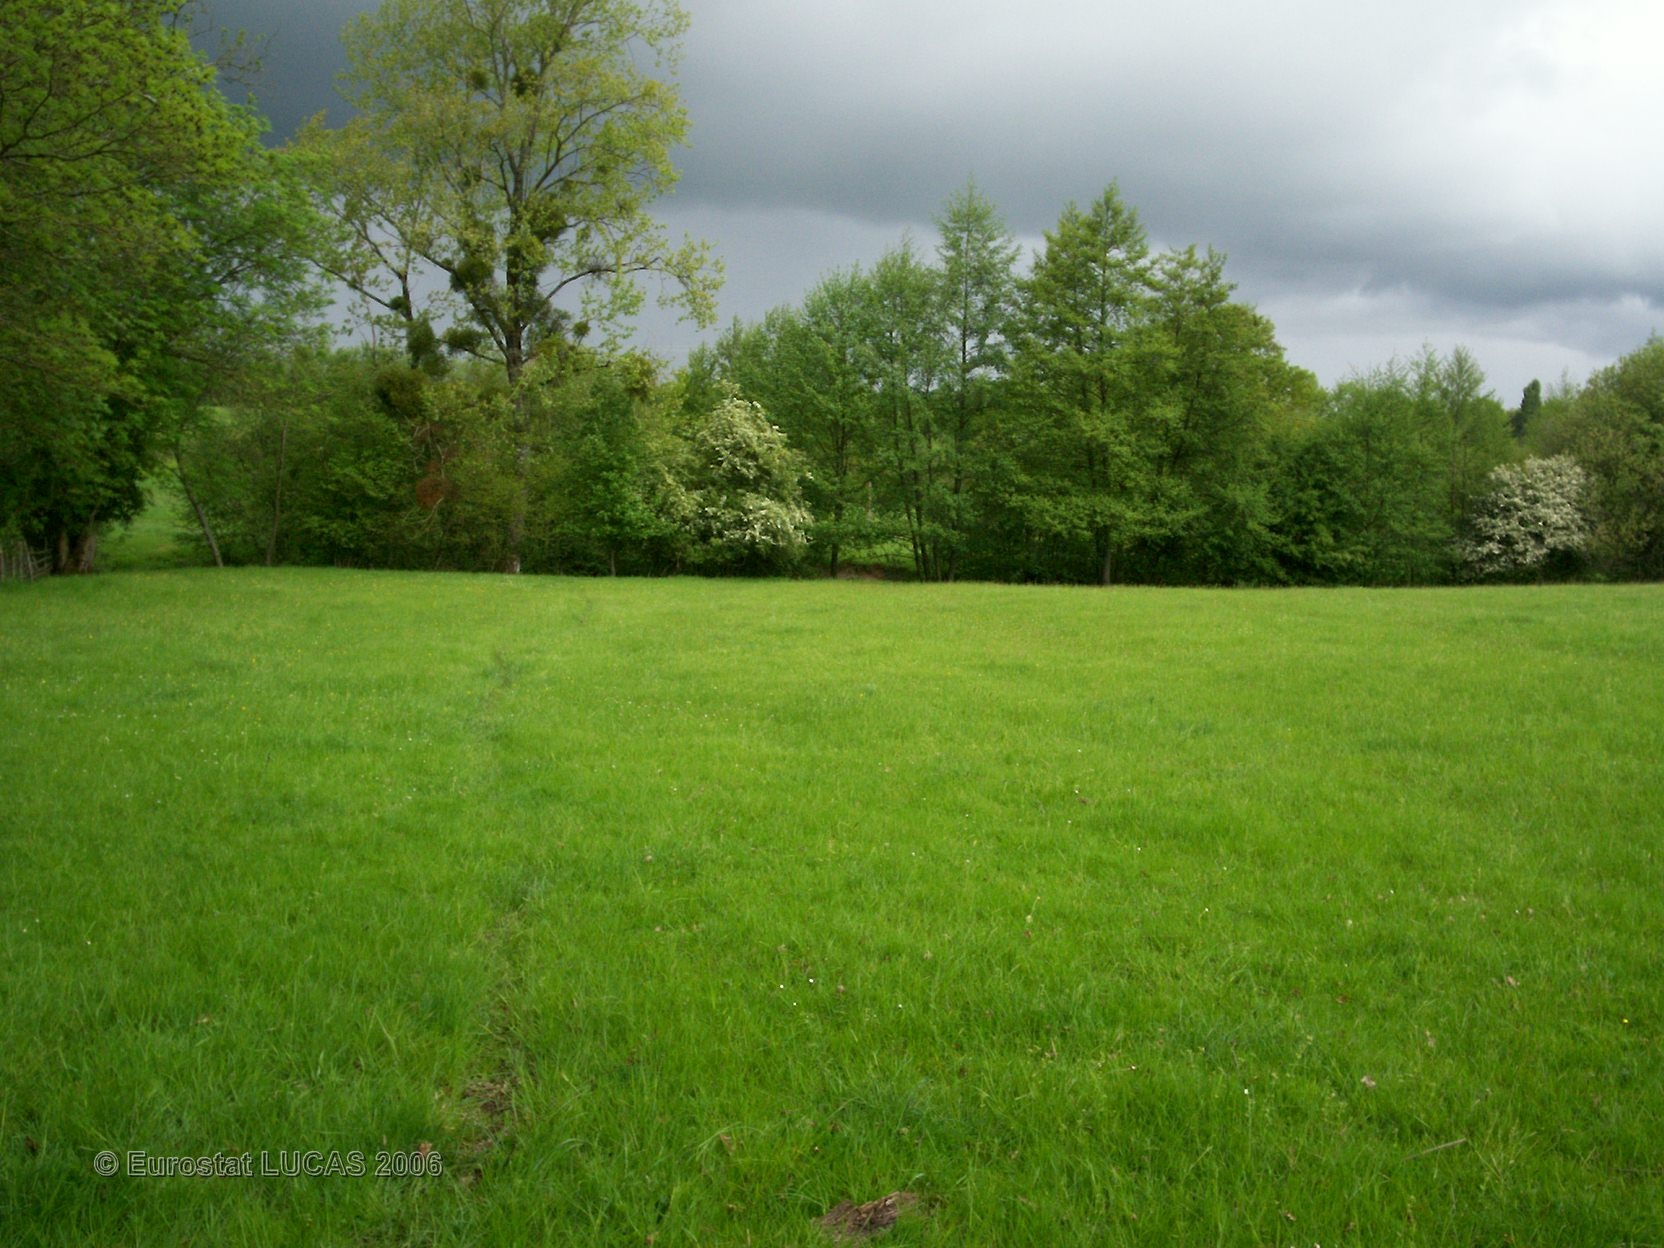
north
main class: Grassland
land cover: Grassland without tree/shrub cover
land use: Agriculture (excluding fallow land and kitchen gardens)
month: May
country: FR
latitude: 46.6351
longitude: -0.2791
